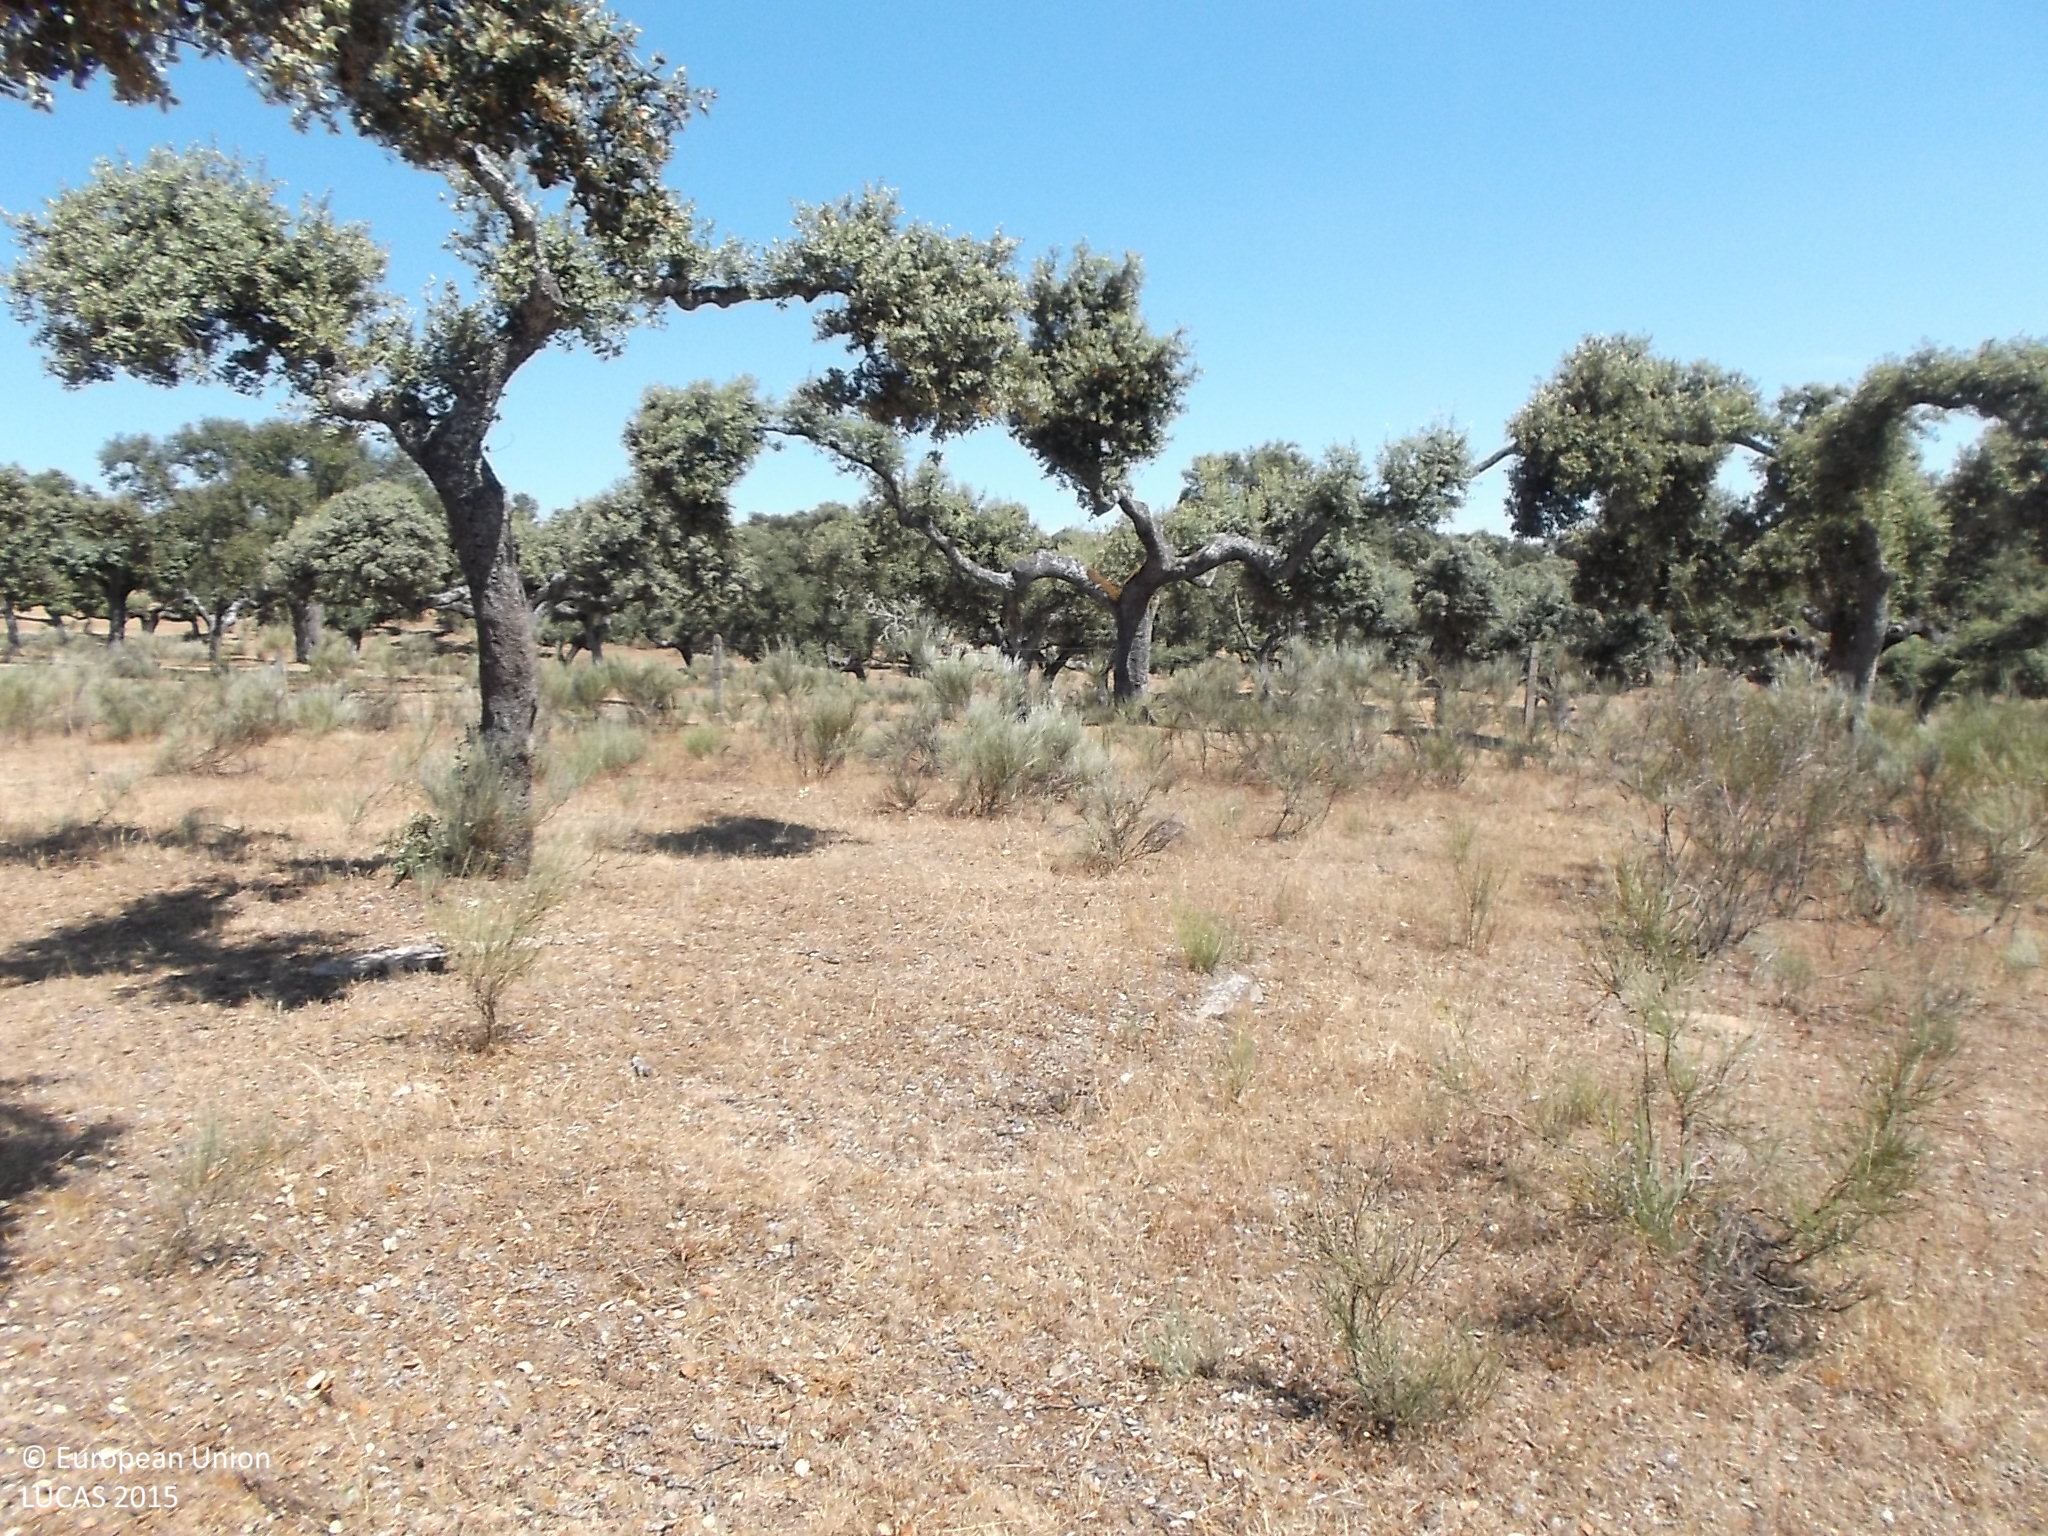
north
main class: Woodland
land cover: Broadleaved woodland
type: broadleaved evergreen forest
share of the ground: 50 - 75 %
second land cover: Shrubland without tree cover
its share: 10 - 25 %
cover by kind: broadleaved forest trees 60 %, shrubs 20 %, herbaceous plants 20 %
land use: Forestry
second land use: Agriculture (excluding fallow land and kitchen gardens)
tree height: < 5 m
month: July
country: ES
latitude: 40.6469
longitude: -6.7095
